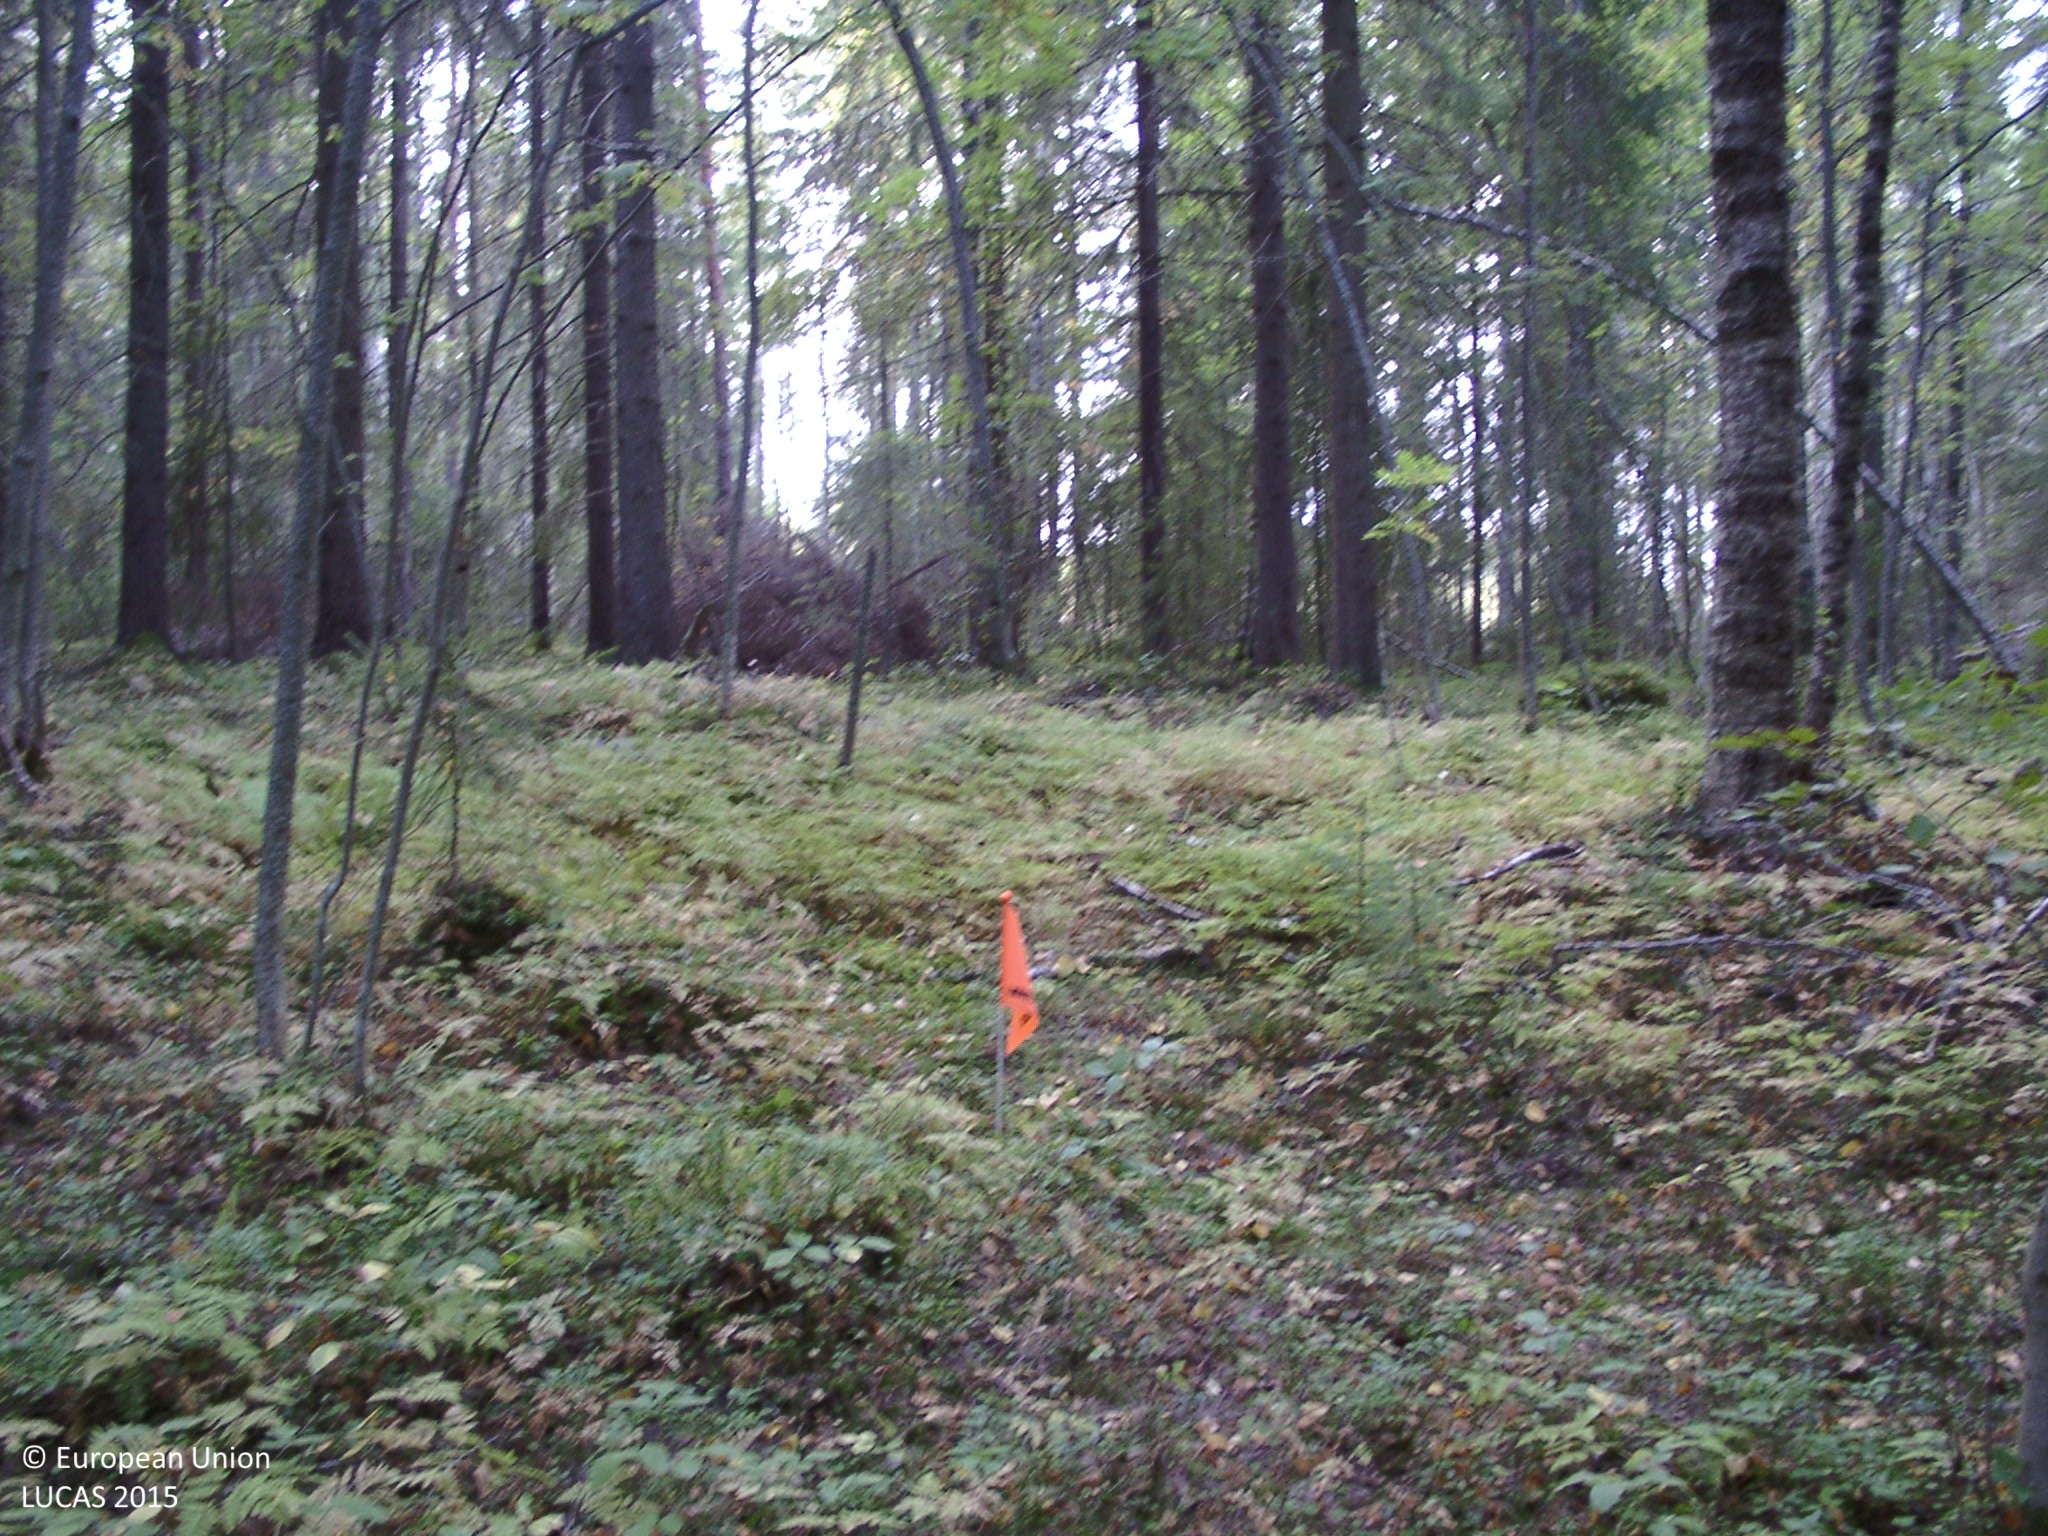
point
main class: Woodland
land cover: Spruce dominated mixed woodland
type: boreal forest
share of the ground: > 75 %
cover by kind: coniferous forest trees 45 %, broadleaved forest trees 40 %, herbaceous plants 10 %, lichens and mosses 5 %
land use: Forestry
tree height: > 5 m
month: September
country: FI
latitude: 62.6051
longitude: 25.7604
